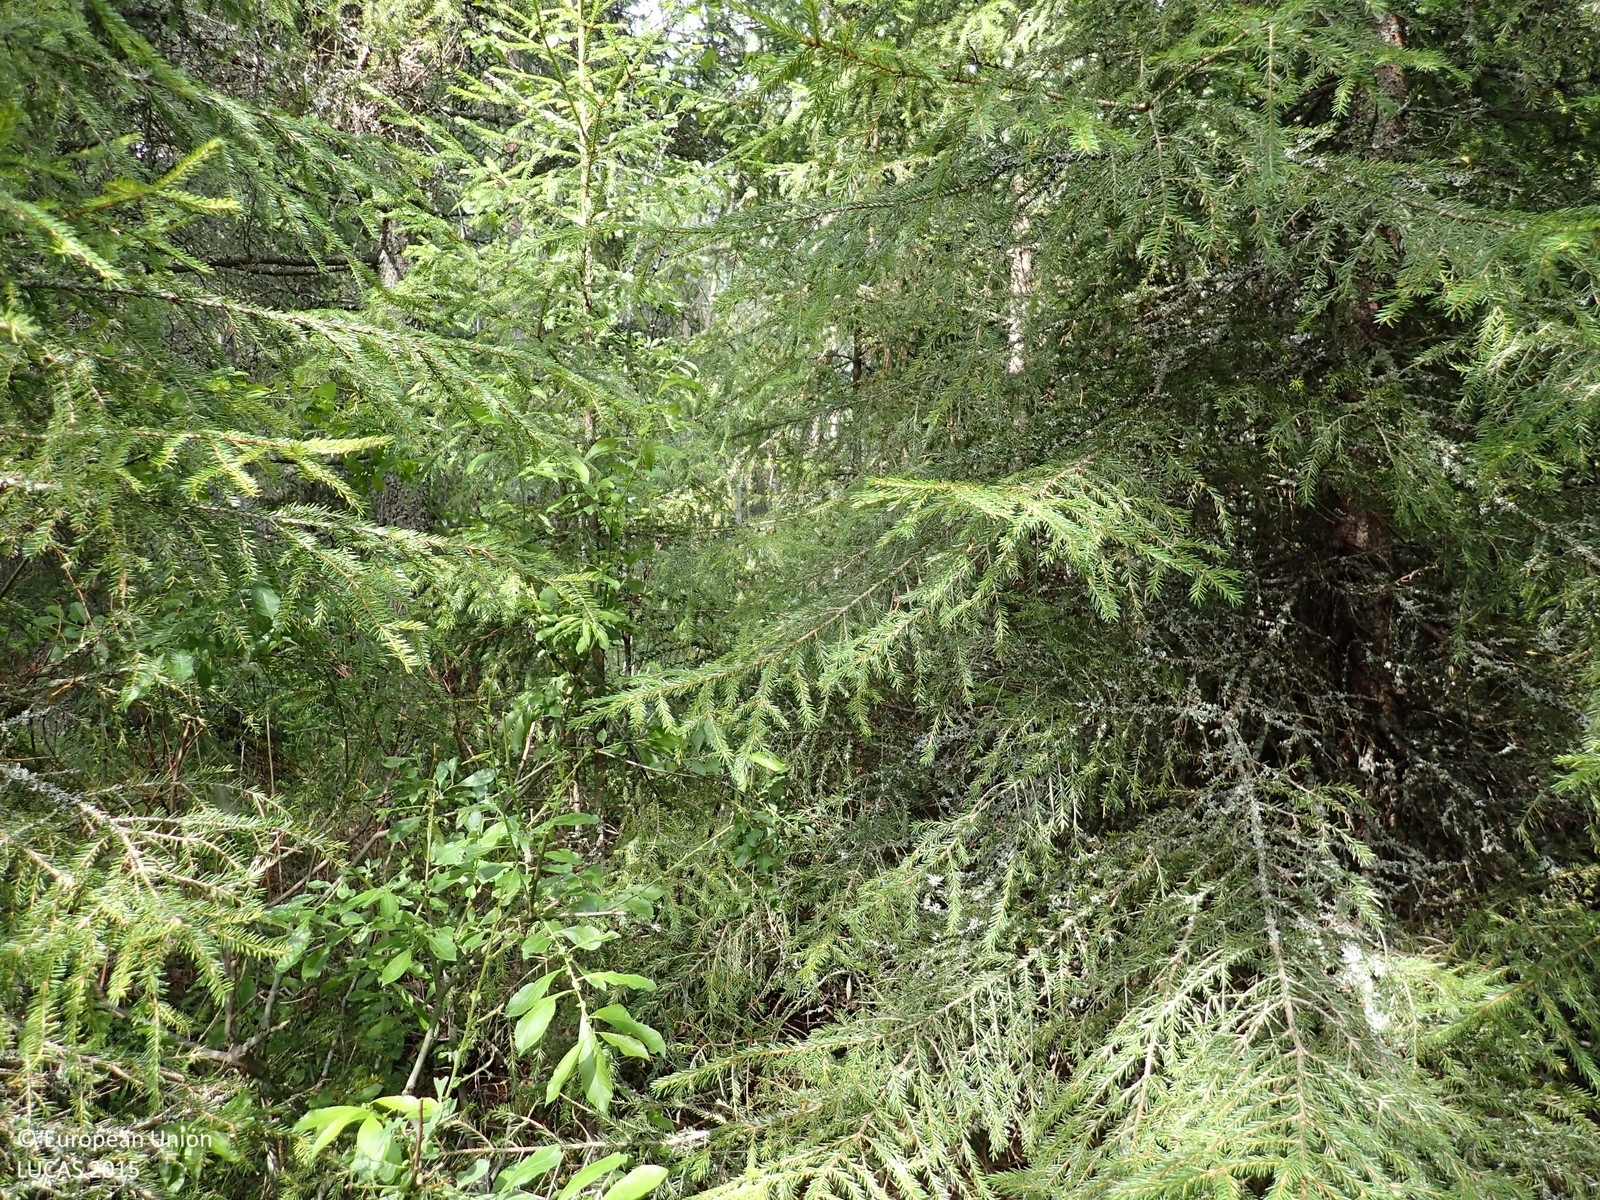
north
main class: Woodland
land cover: Spruce dominated mixed woodland
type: boreal forest
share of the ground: > 75 %
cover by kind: broadleaved forest trees 60 %, coniferous forest trees 25 %, shrubs 10 %, herbaceous plants 5 %
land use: Forestry
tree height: > 5 m
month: August
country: FI
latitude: 62.8521
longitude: 21.8907
